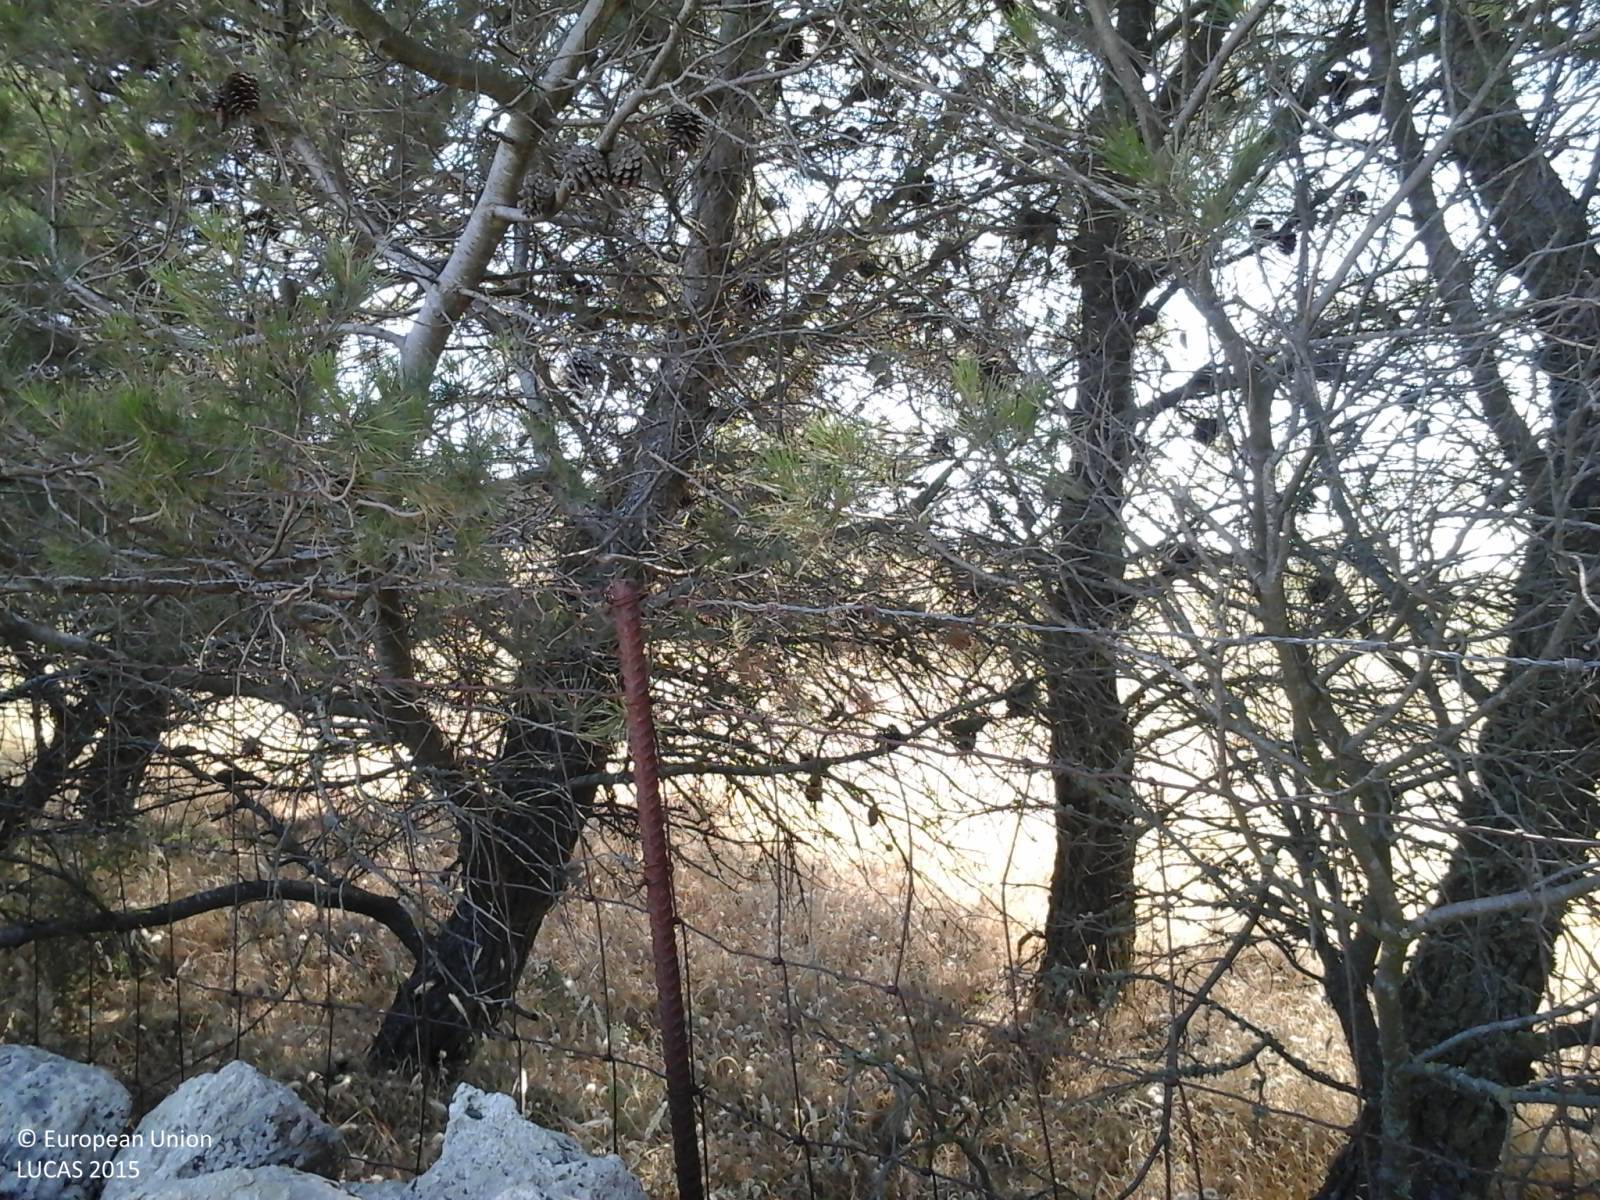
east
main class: Grassland
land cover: Grassland without tree/shrub cover
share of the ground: > 75 %
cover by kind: herbaceous plants 100 %
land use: Agriculture (excluding fallow land and kitchen gardens)
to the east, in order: Grassland without tree/shrub cover; Electric lines; Grassland without tree/shrub cover; Fences; Grassland without tree/shrub cover
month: June
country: IT
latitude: 40.5308
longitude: 8.7431
